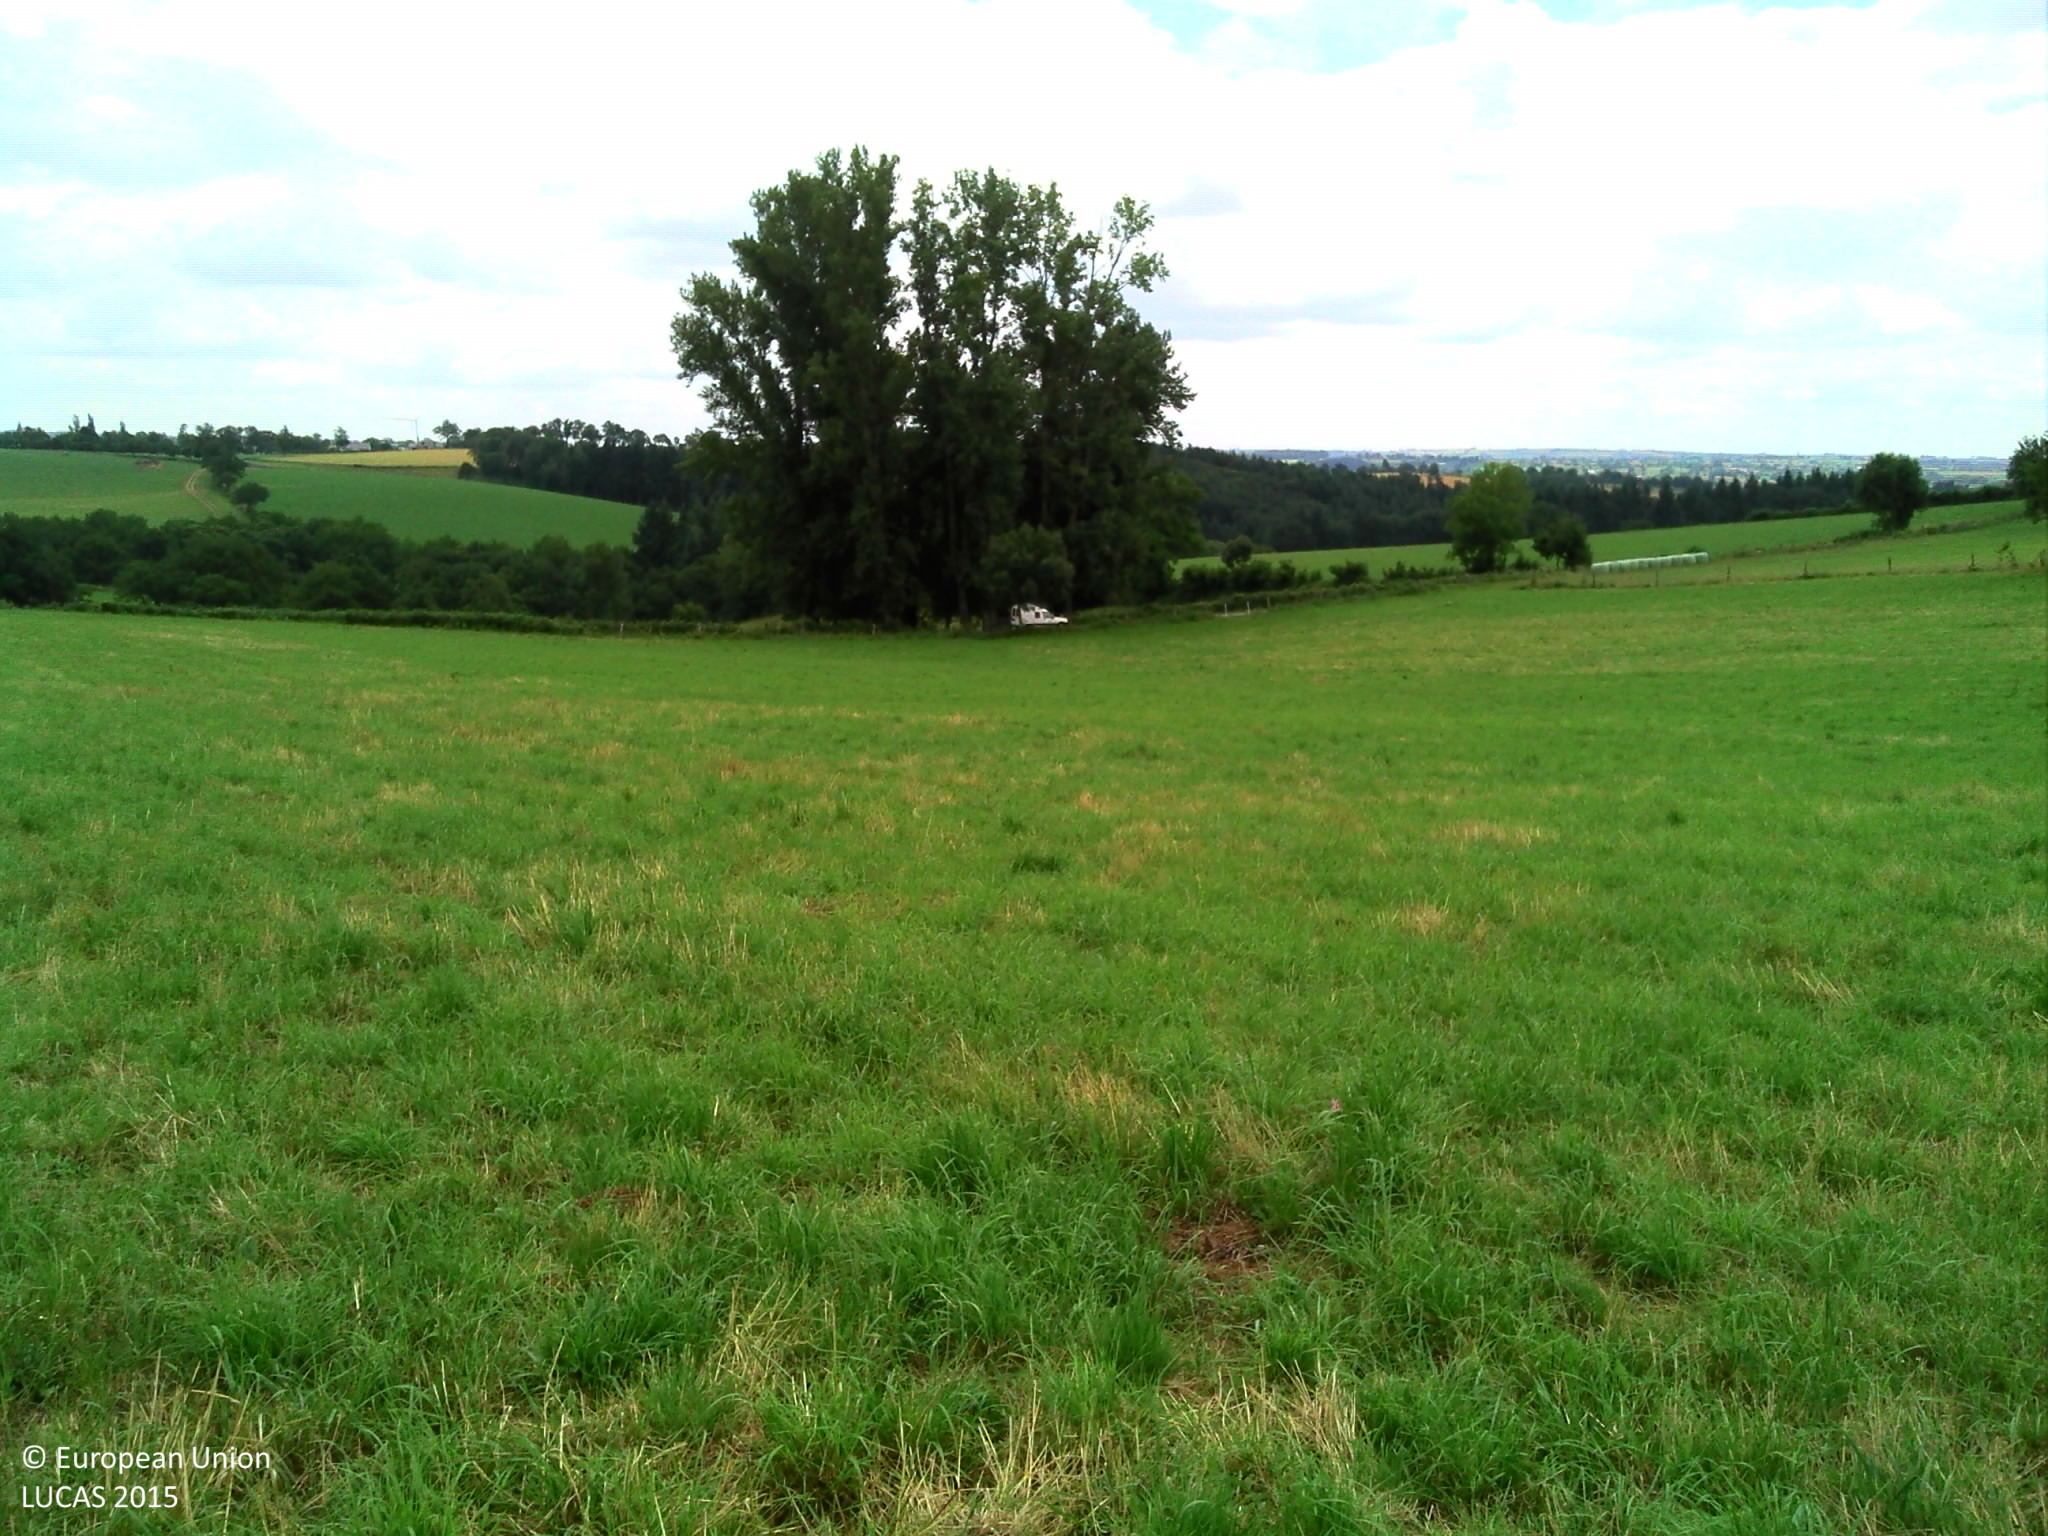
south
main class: Cropland
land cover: Temporary grasslands
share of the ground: > 75 %
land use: Agriculture (excluding fallow land and kitchen gardens)
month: June
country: FR
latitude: 44.2421
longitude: 2.5030
